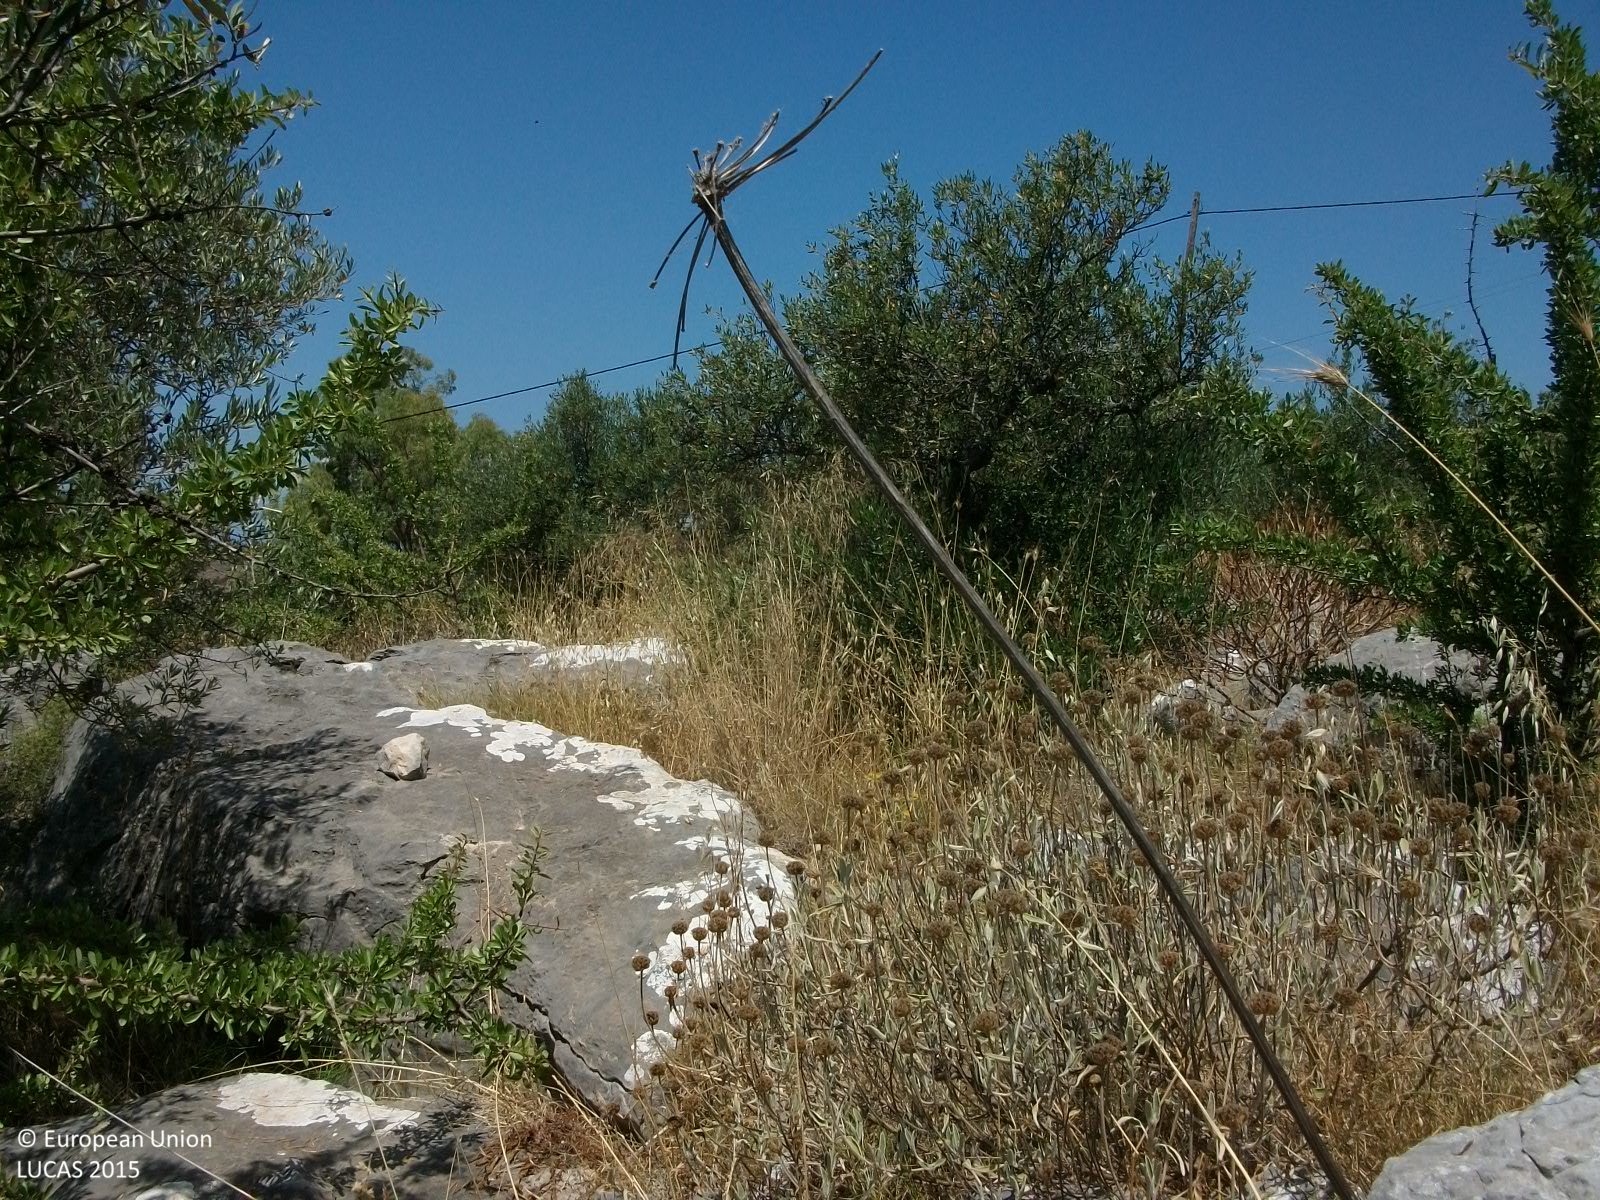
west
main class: Cropland
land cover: Olive groves
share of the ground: 25 - 50 %
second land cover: Spontaneously vegetated surfaces
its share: > 75 %
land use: Agriculture (excluding fallow land and kitchen gardens)
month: July
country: GR
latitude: 36.7170
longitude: 22.3663
